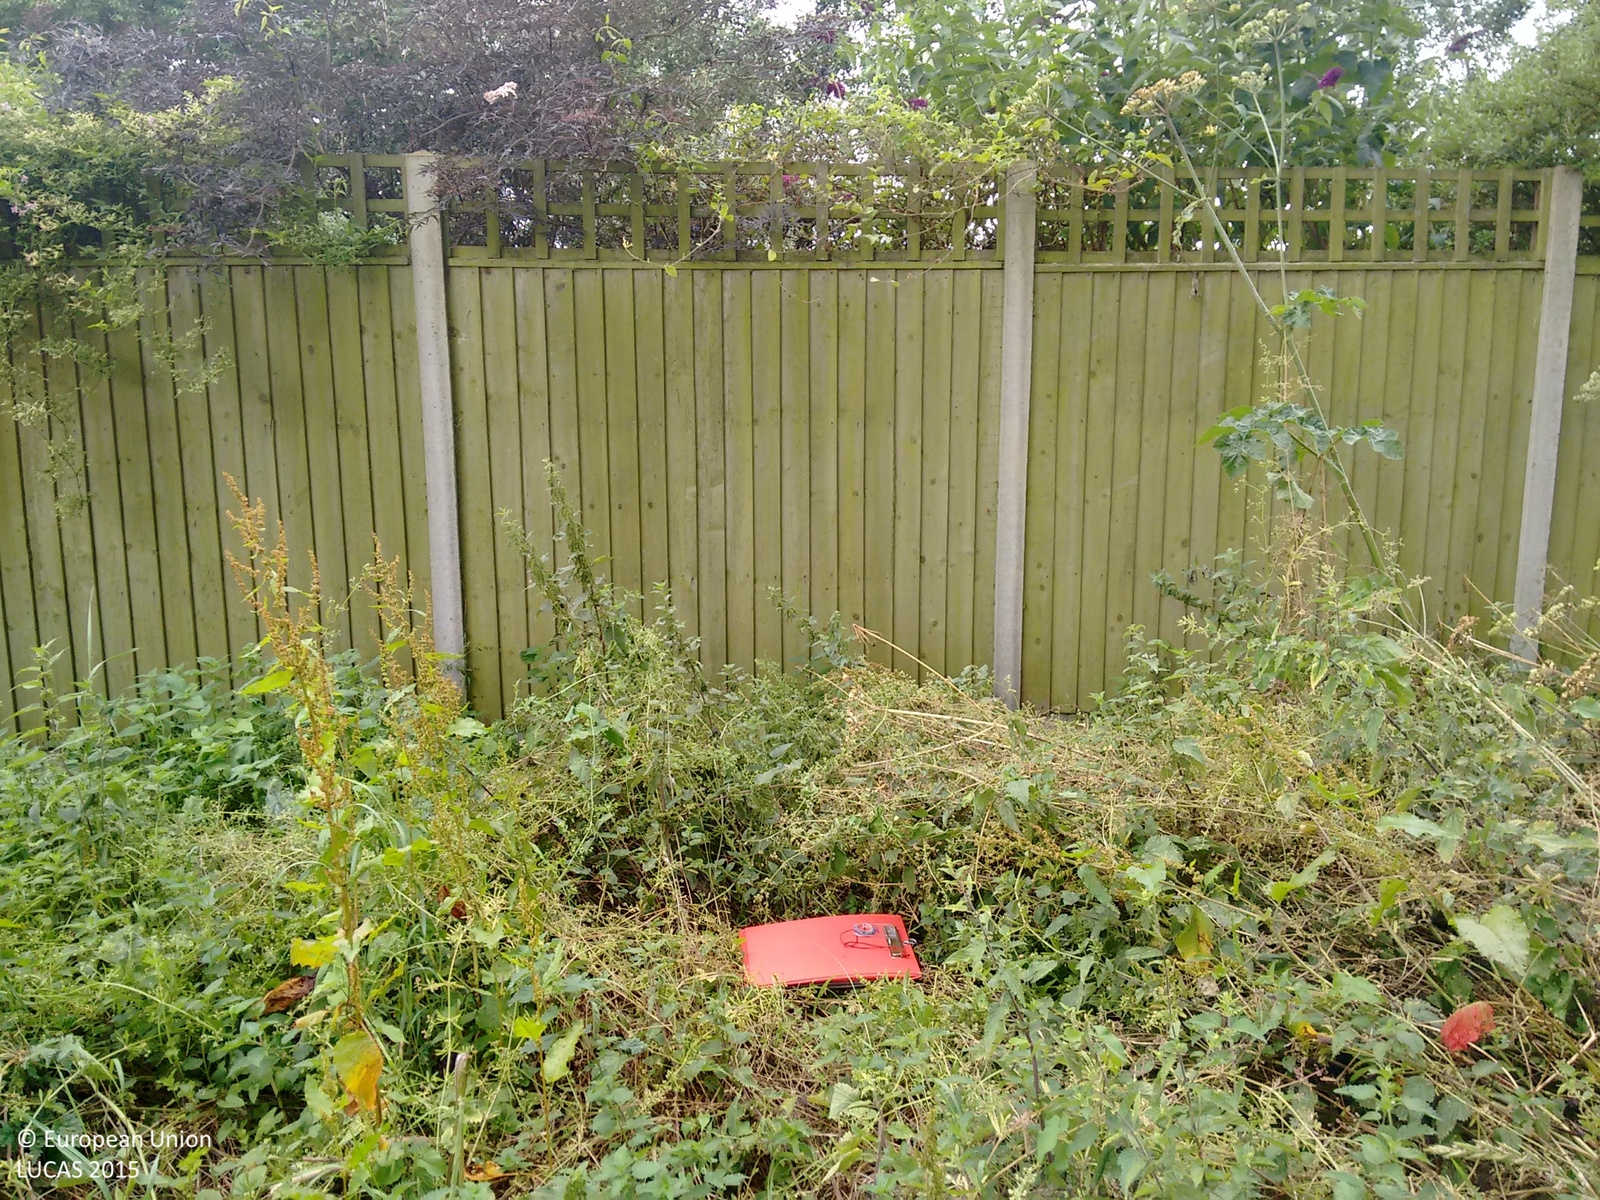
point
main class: Grassland
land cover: Grassland with sparse tree/shrub cover
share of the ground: > 75 %
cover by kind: herbaceous plants 90 %, broadleaved forest trees 5 %, shrubs 5 %
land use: Amenities, museums, leisure
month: July
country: GB
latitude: 52.4034
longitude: -1.4415
